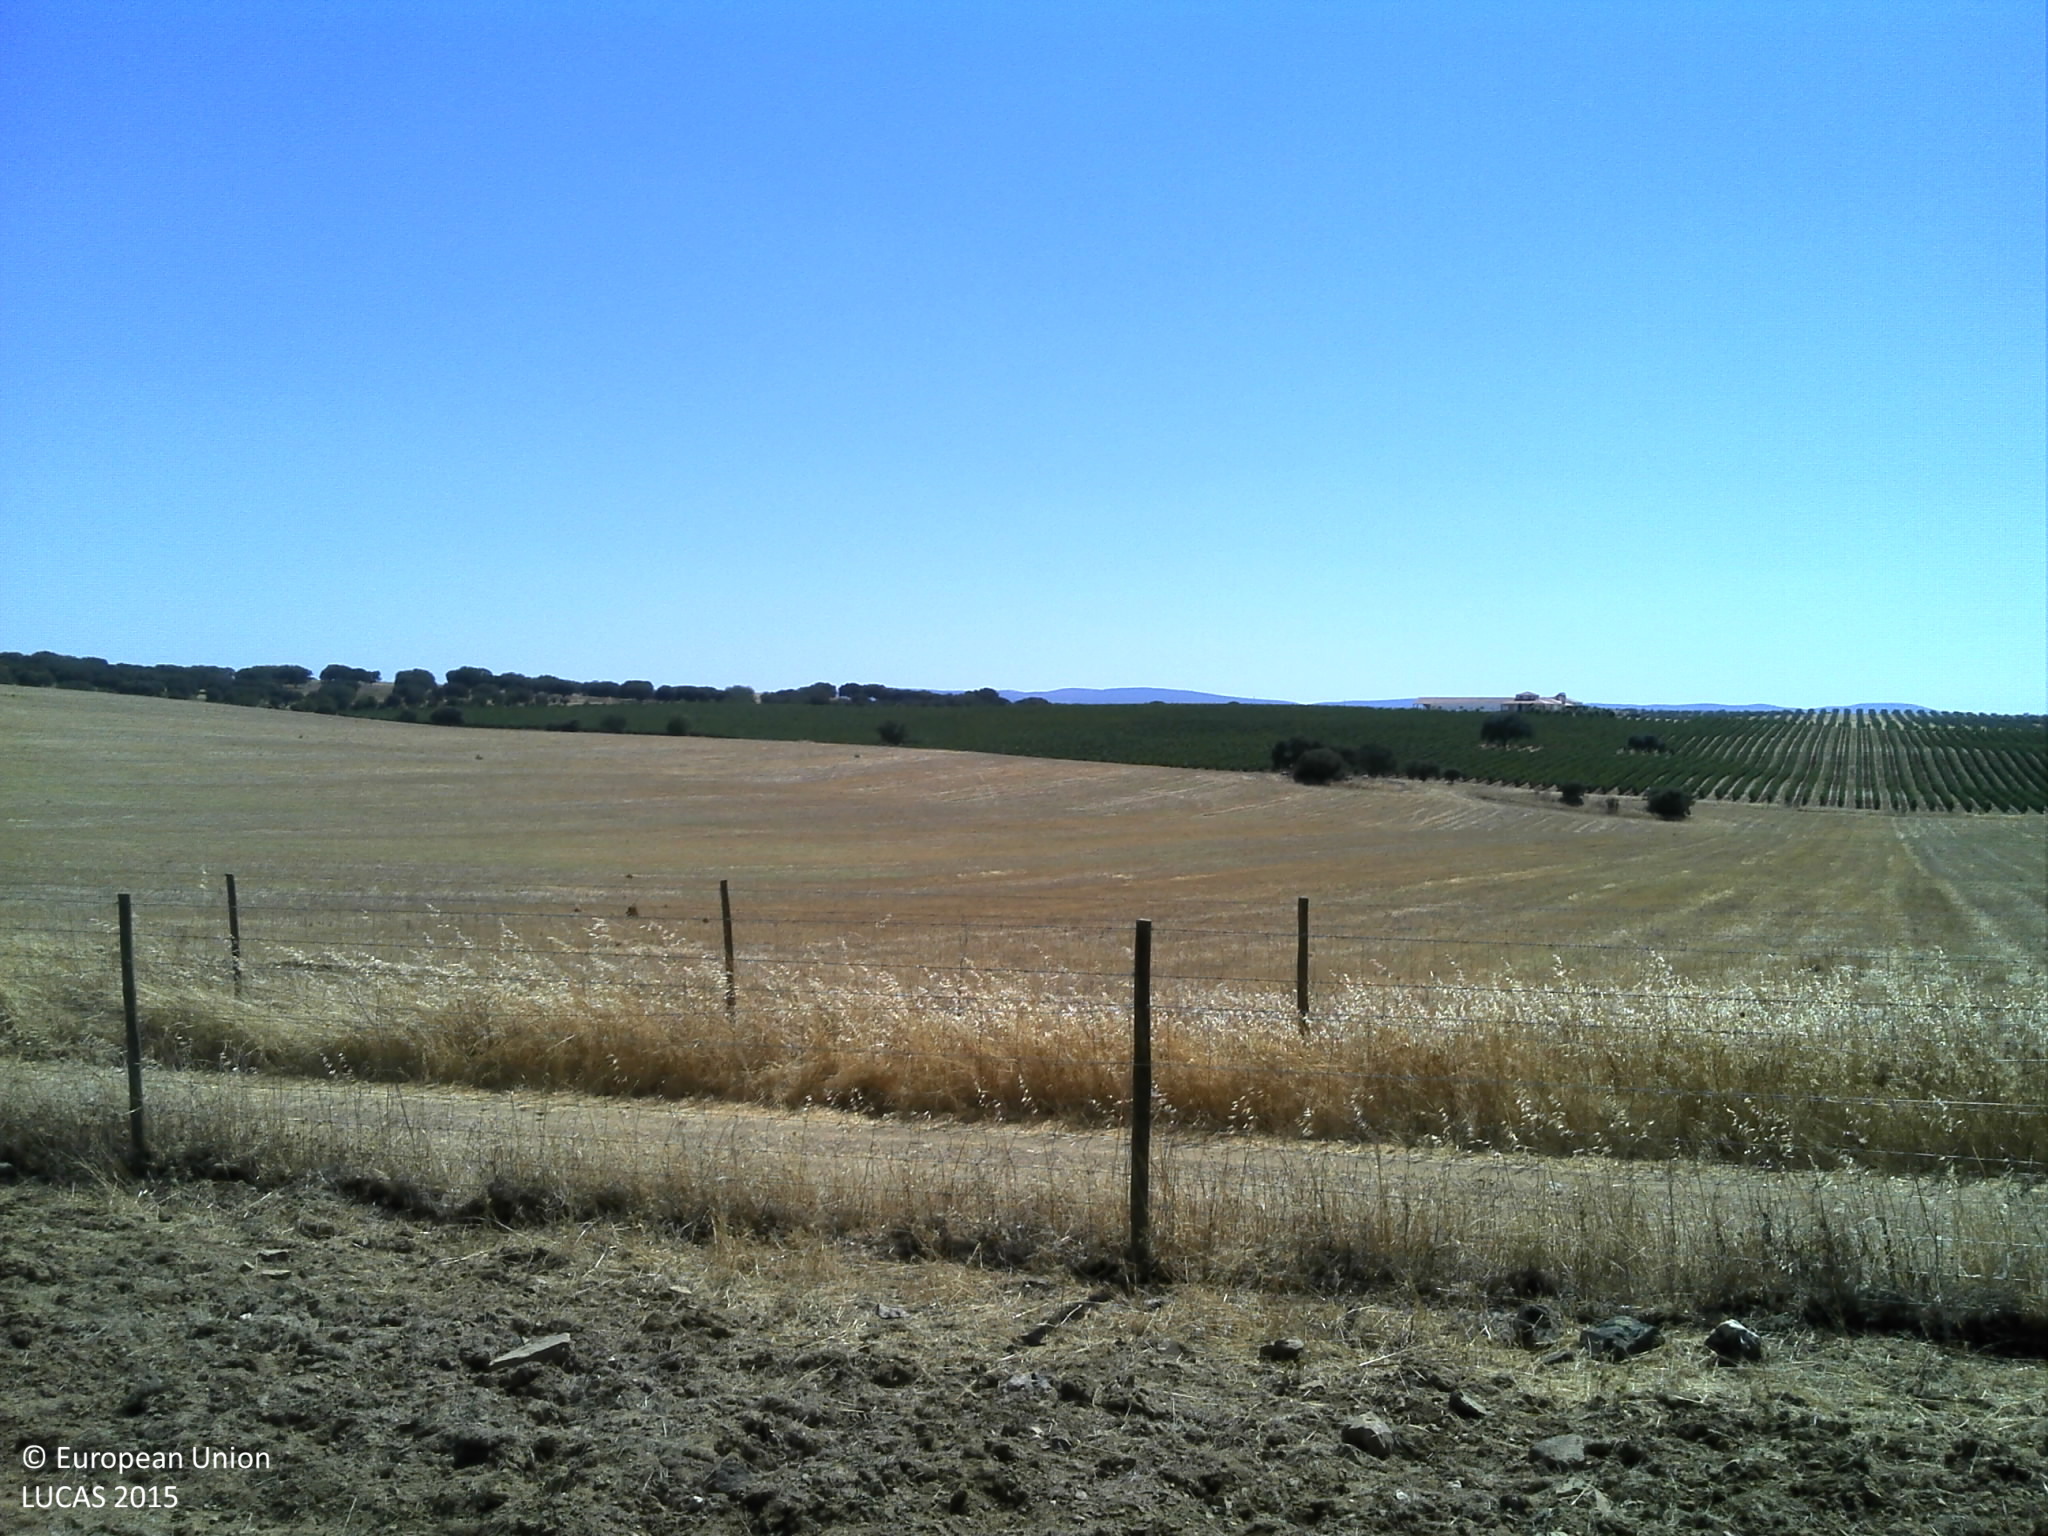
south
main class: Woodland
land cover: Broadleaved woodland
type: broadleaved evergreen forest
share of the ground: 25 - 50 %
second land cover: Grassland without tree/shrub cover
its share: 10 - 25 %
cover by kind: unconsolidated bare surface 55 %, broadleaved forest trees 25 %, herbaceous plants 20 %
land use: Forestry
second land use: Agriculture (excluding fallow land and kitchen gardens)
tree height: > 5 m
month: July
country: PT
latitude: 39.0243
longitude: -7.5384
